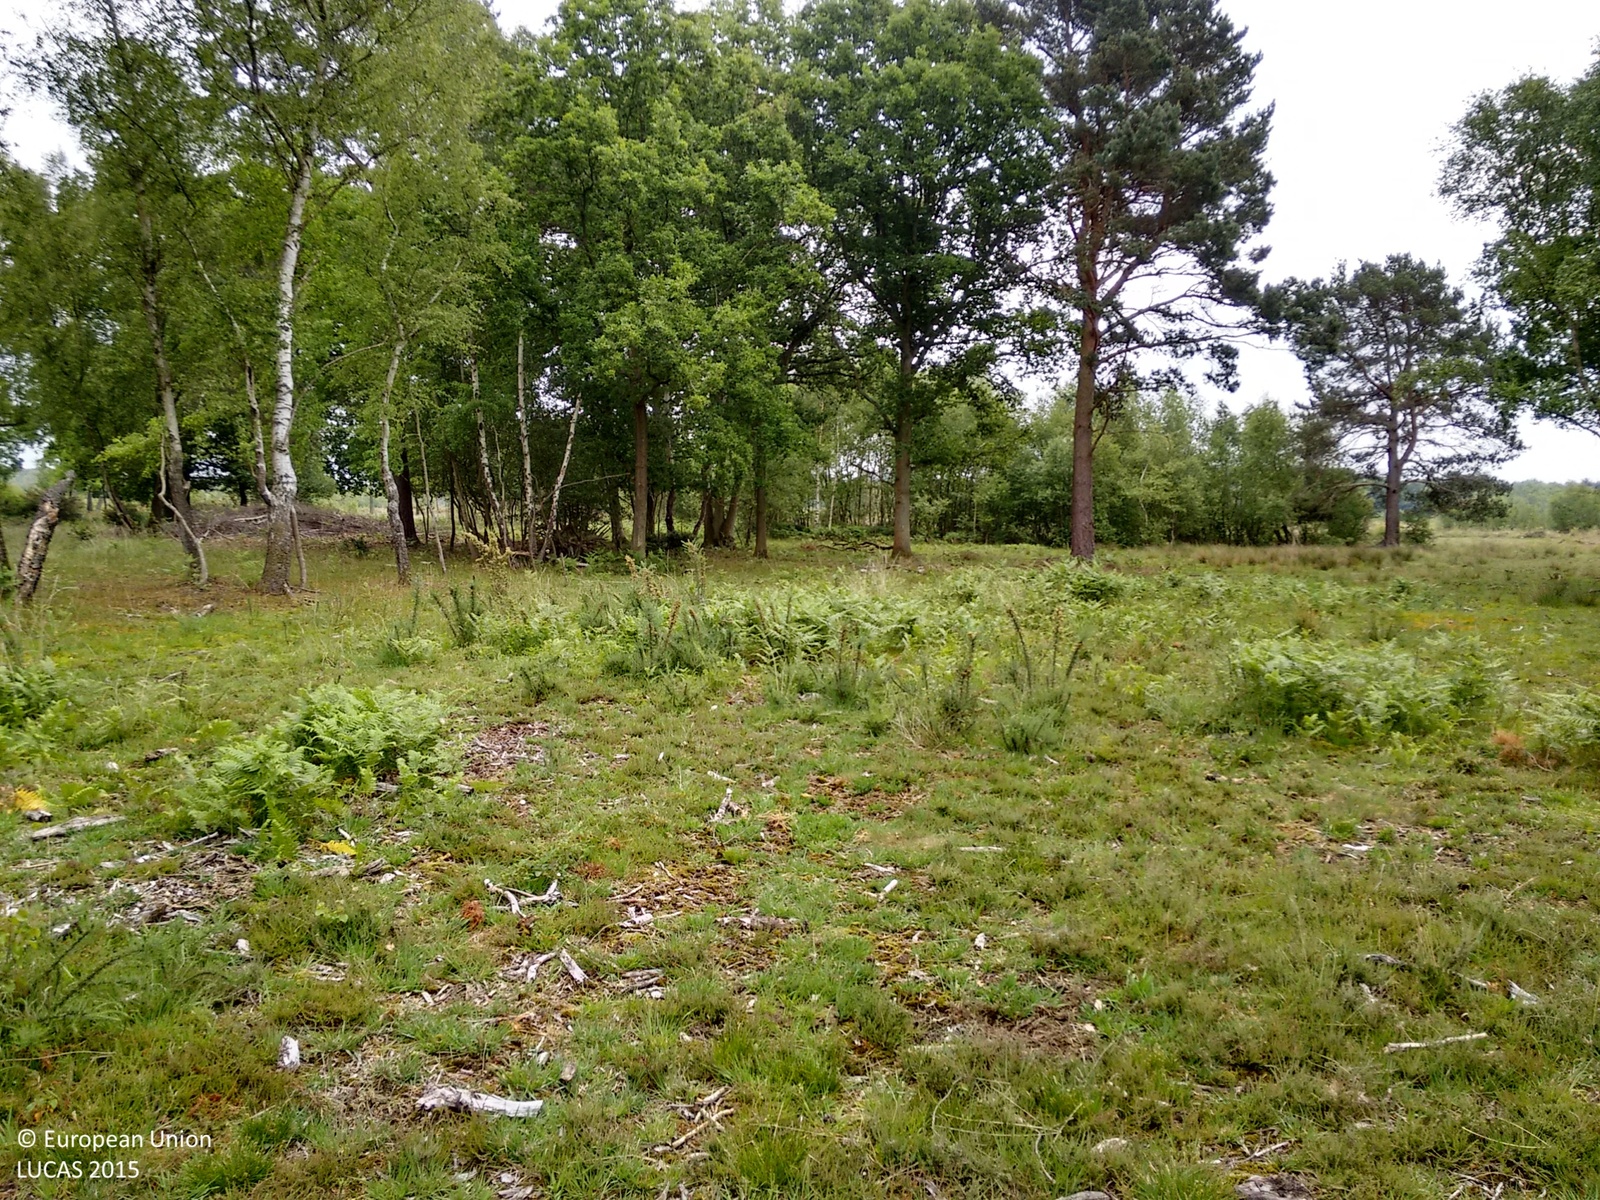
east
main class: Woodland
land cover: Other mixed woodland
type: mesophytic deciduous forest
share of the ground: 25 - 50 %
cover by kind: herbaceous plants 50 %, coniferous forest trees 30 %, broadleaved forest trees 20 %
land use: Forestry
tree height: < 5 m
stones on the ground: 10 - 25 %
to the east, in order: Other mixed woodland; Grassland with sparse tree/shrub cover; Tracks; Grassland with sparse tree/shrub cover
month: June
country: GB
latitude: 51.5584
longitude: -0.5833
